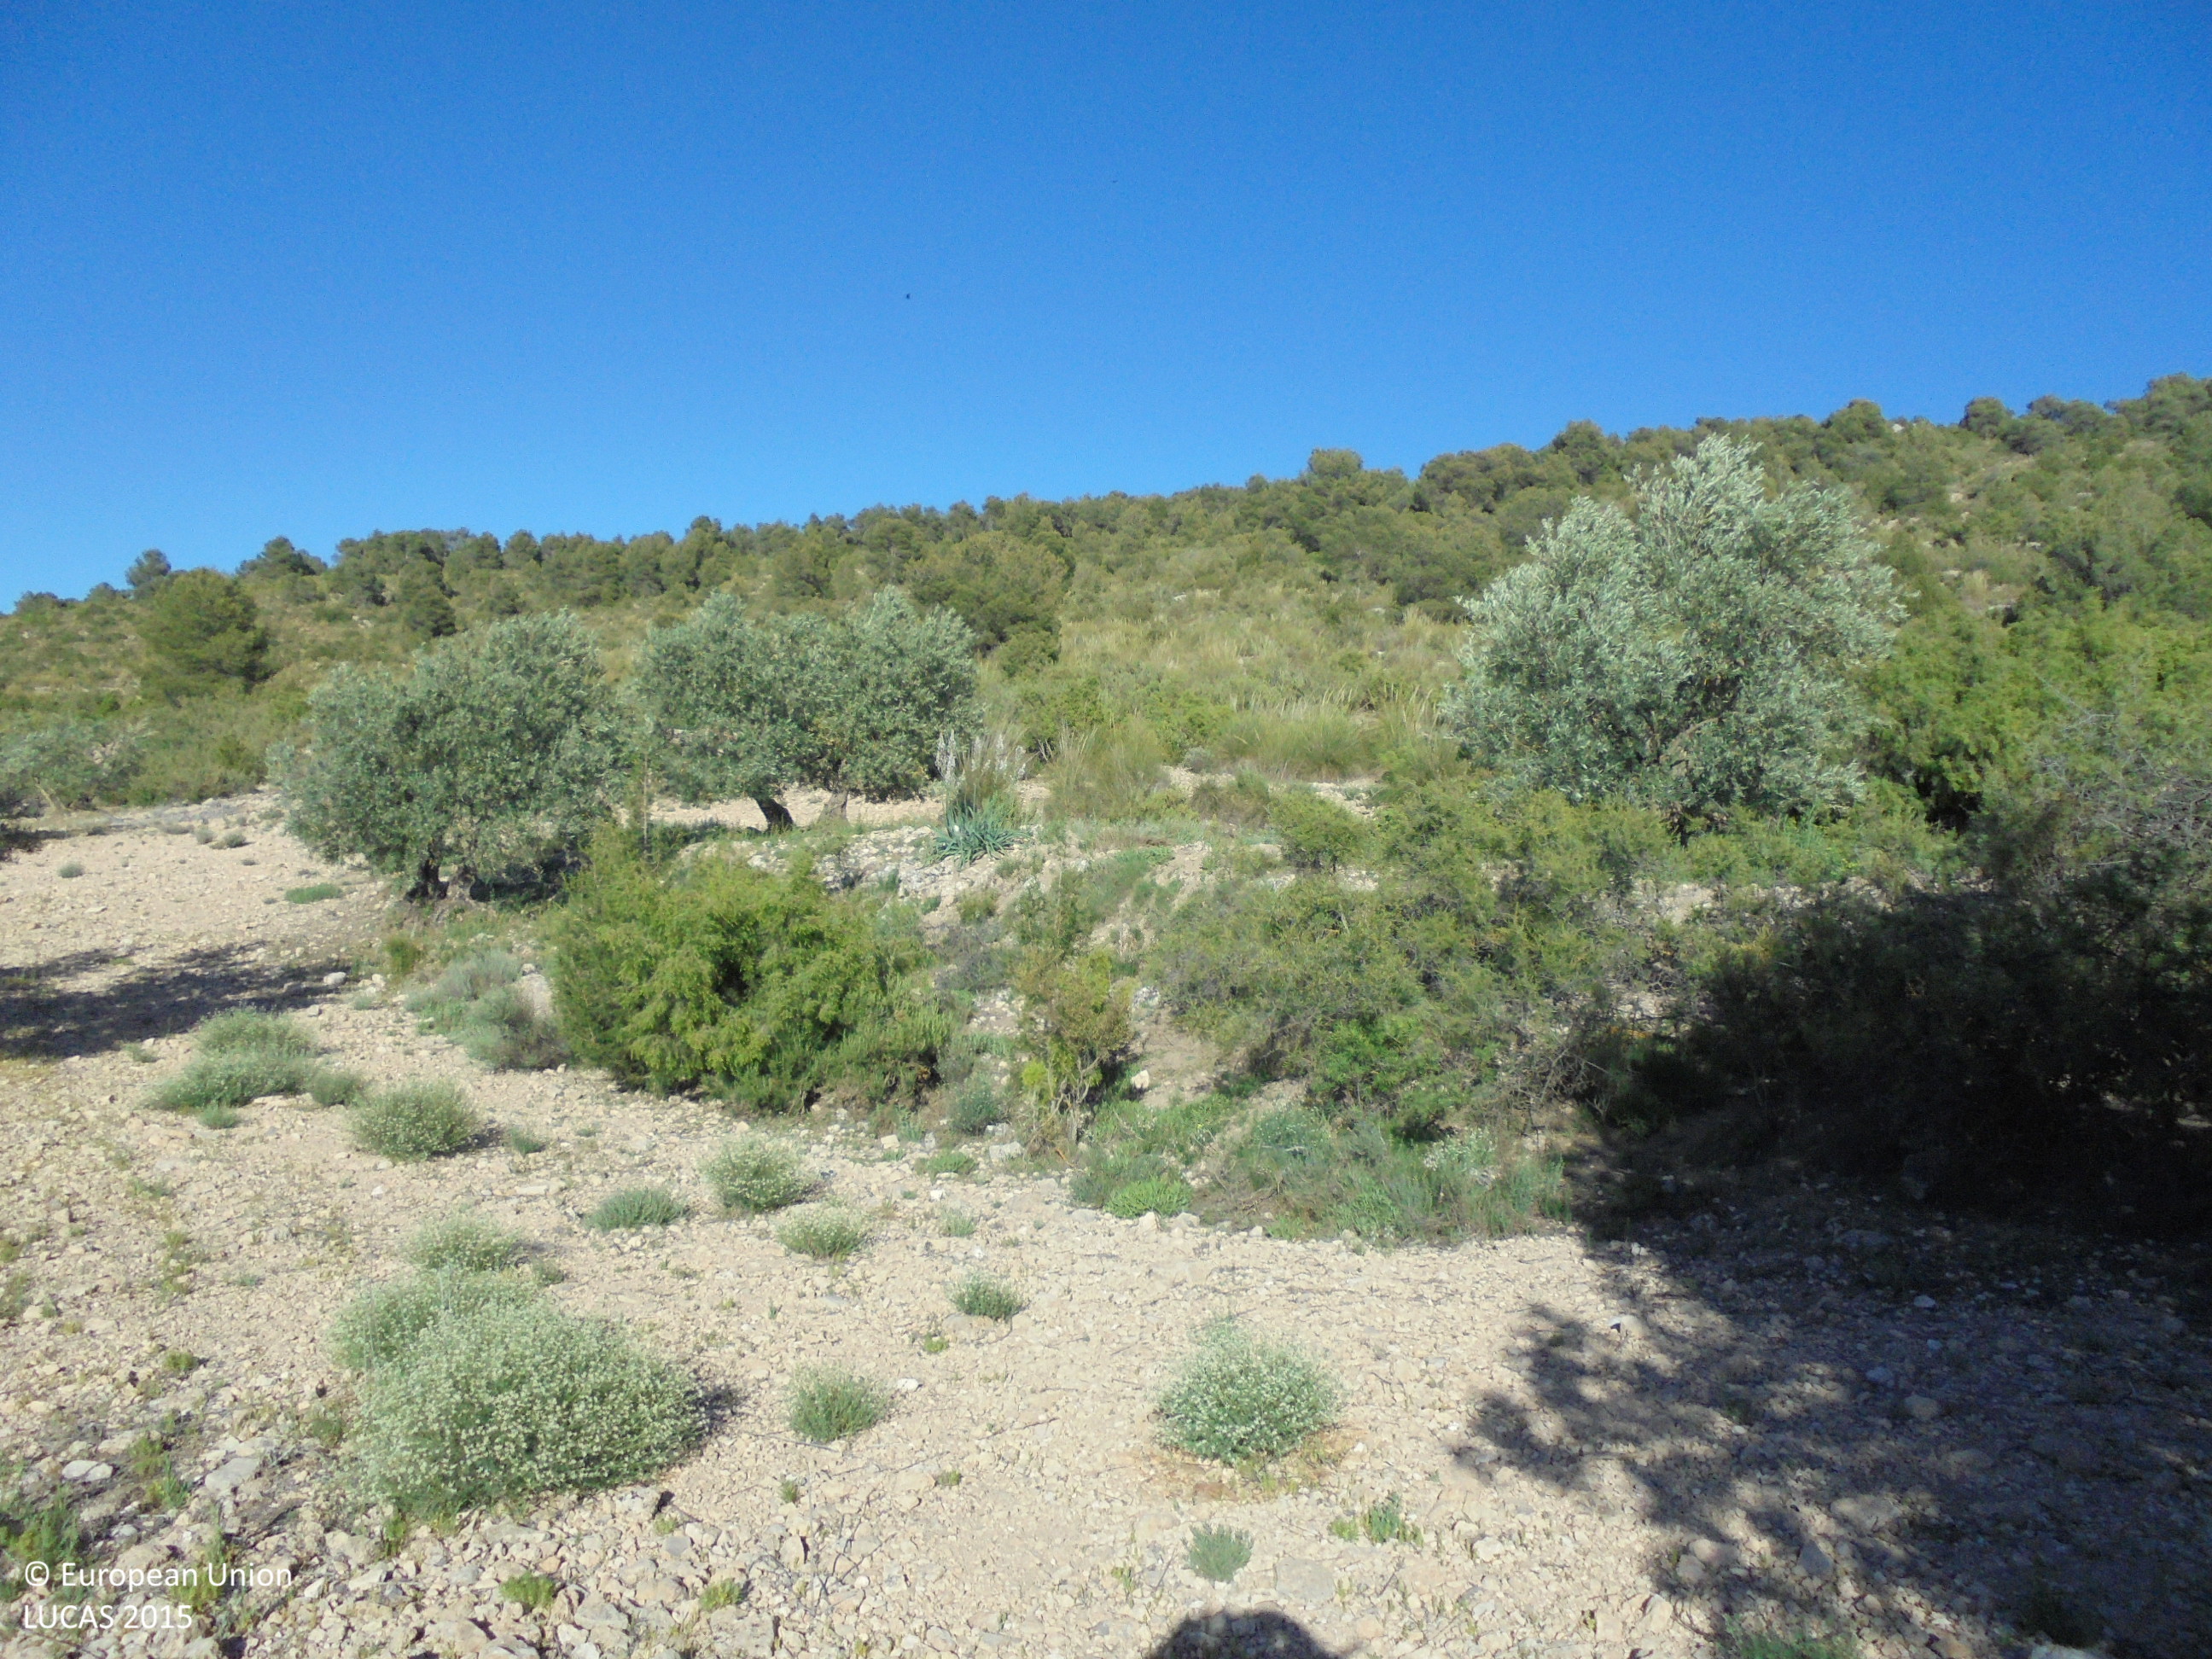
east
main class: Cropland
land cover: Olive groves
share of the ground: 10 - 25 %
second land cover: Spontaneously vegetated surfaces
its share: 50 - 75 %
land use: Agriculture (excluding fallow land and kitchen gardens)
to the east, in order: Olive groves; Spontaneously vegetated surfaces; Shrubland without tree cover; Dry stone walls; Olive groves; Shrubland with sparse tree cover; Pine dominated coniferous woodland
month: May
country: ES
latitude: 39.0800
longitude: -1.4777
